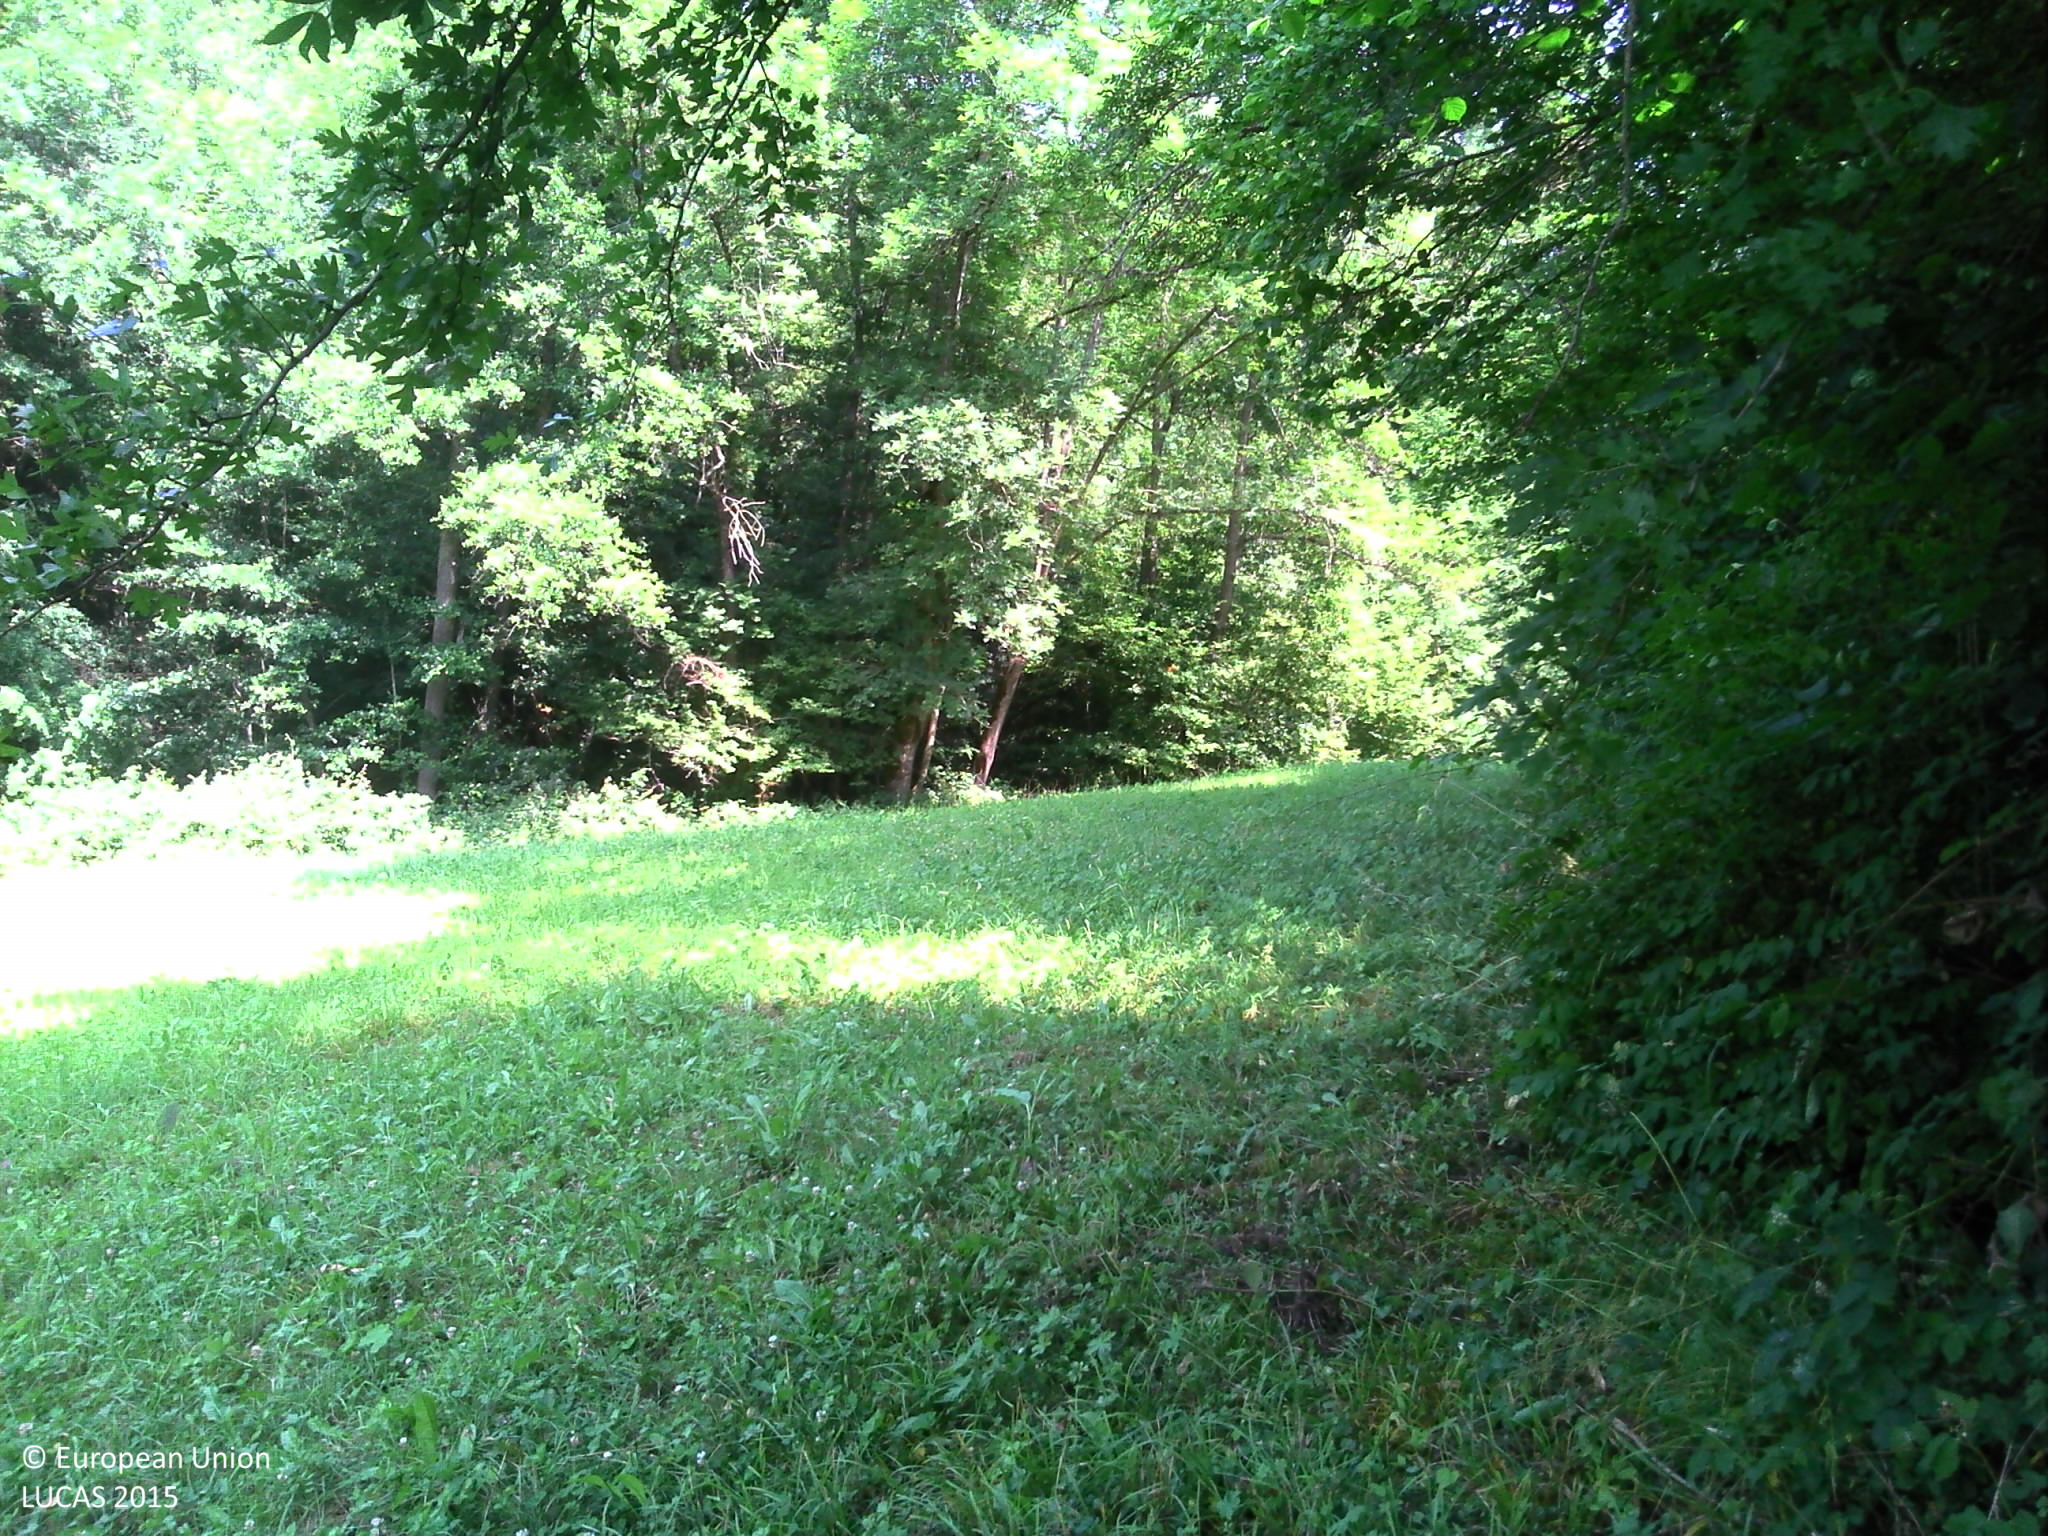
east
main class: Woodland
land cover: Broadleaved woodland
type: mesophytic deciduous forest
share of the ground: > 75 %
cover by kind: broadleaved forest trees 100 %
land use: Forestry
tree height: > 5 m
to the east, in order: Broadleaved woodland; Rivers and streams; Broadleaved woodland; Grass margins; Paved roads, cycling and walking lanes
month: July
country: FR
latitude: 45.2855
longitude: 3.2063
